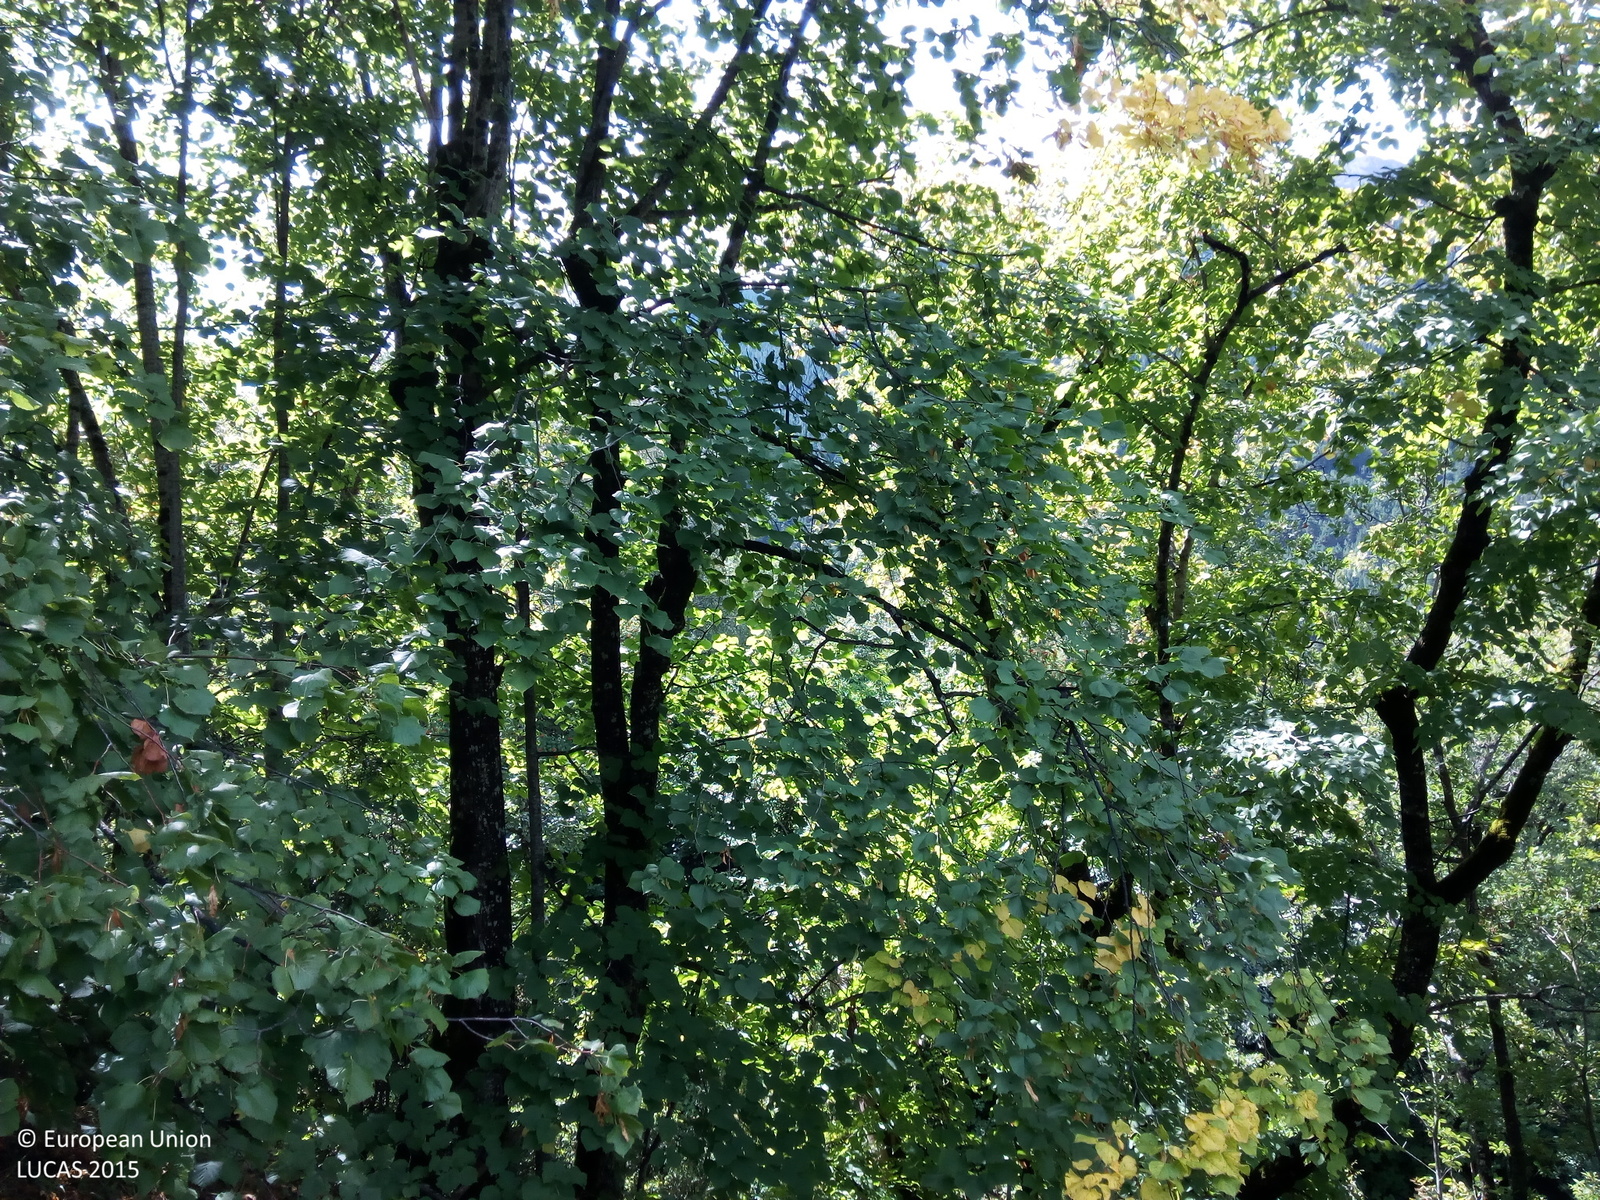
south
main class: Woodland
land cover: Broadleaved woodland
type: floodplain forest
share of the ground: > 75 %
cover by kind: broadleaved forest trees 80 %, herbaceous plants 15 %, shrubs 5 %
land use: Semi-natural and natural areas not in use
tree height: > 5 m
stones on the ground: < 10 %
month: September
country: ES
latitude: 42.5755
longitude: 0.3665
